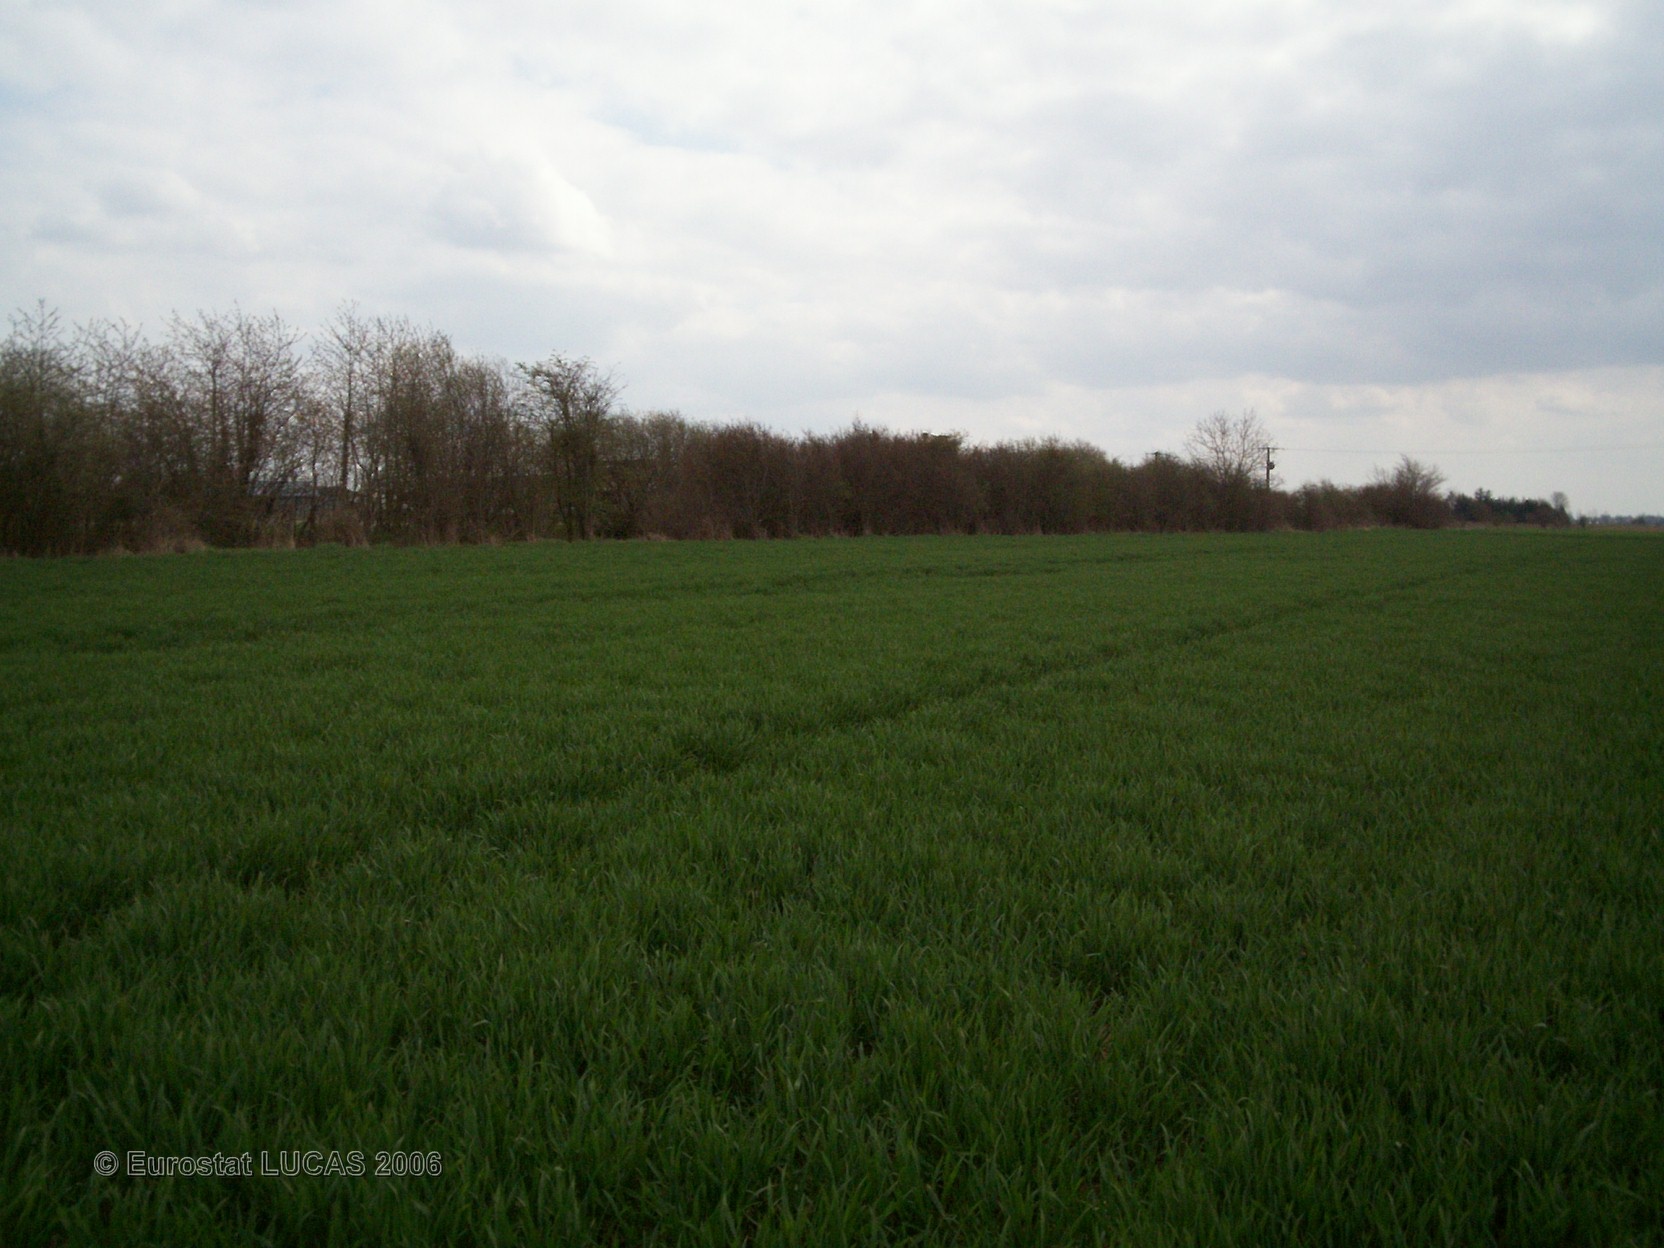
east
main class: Cropland
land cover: Common wheat
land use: Agriculture (excluding fallow land and kitchen gardens)
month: April
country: FR
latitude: 49.1043
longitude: 1.0064
